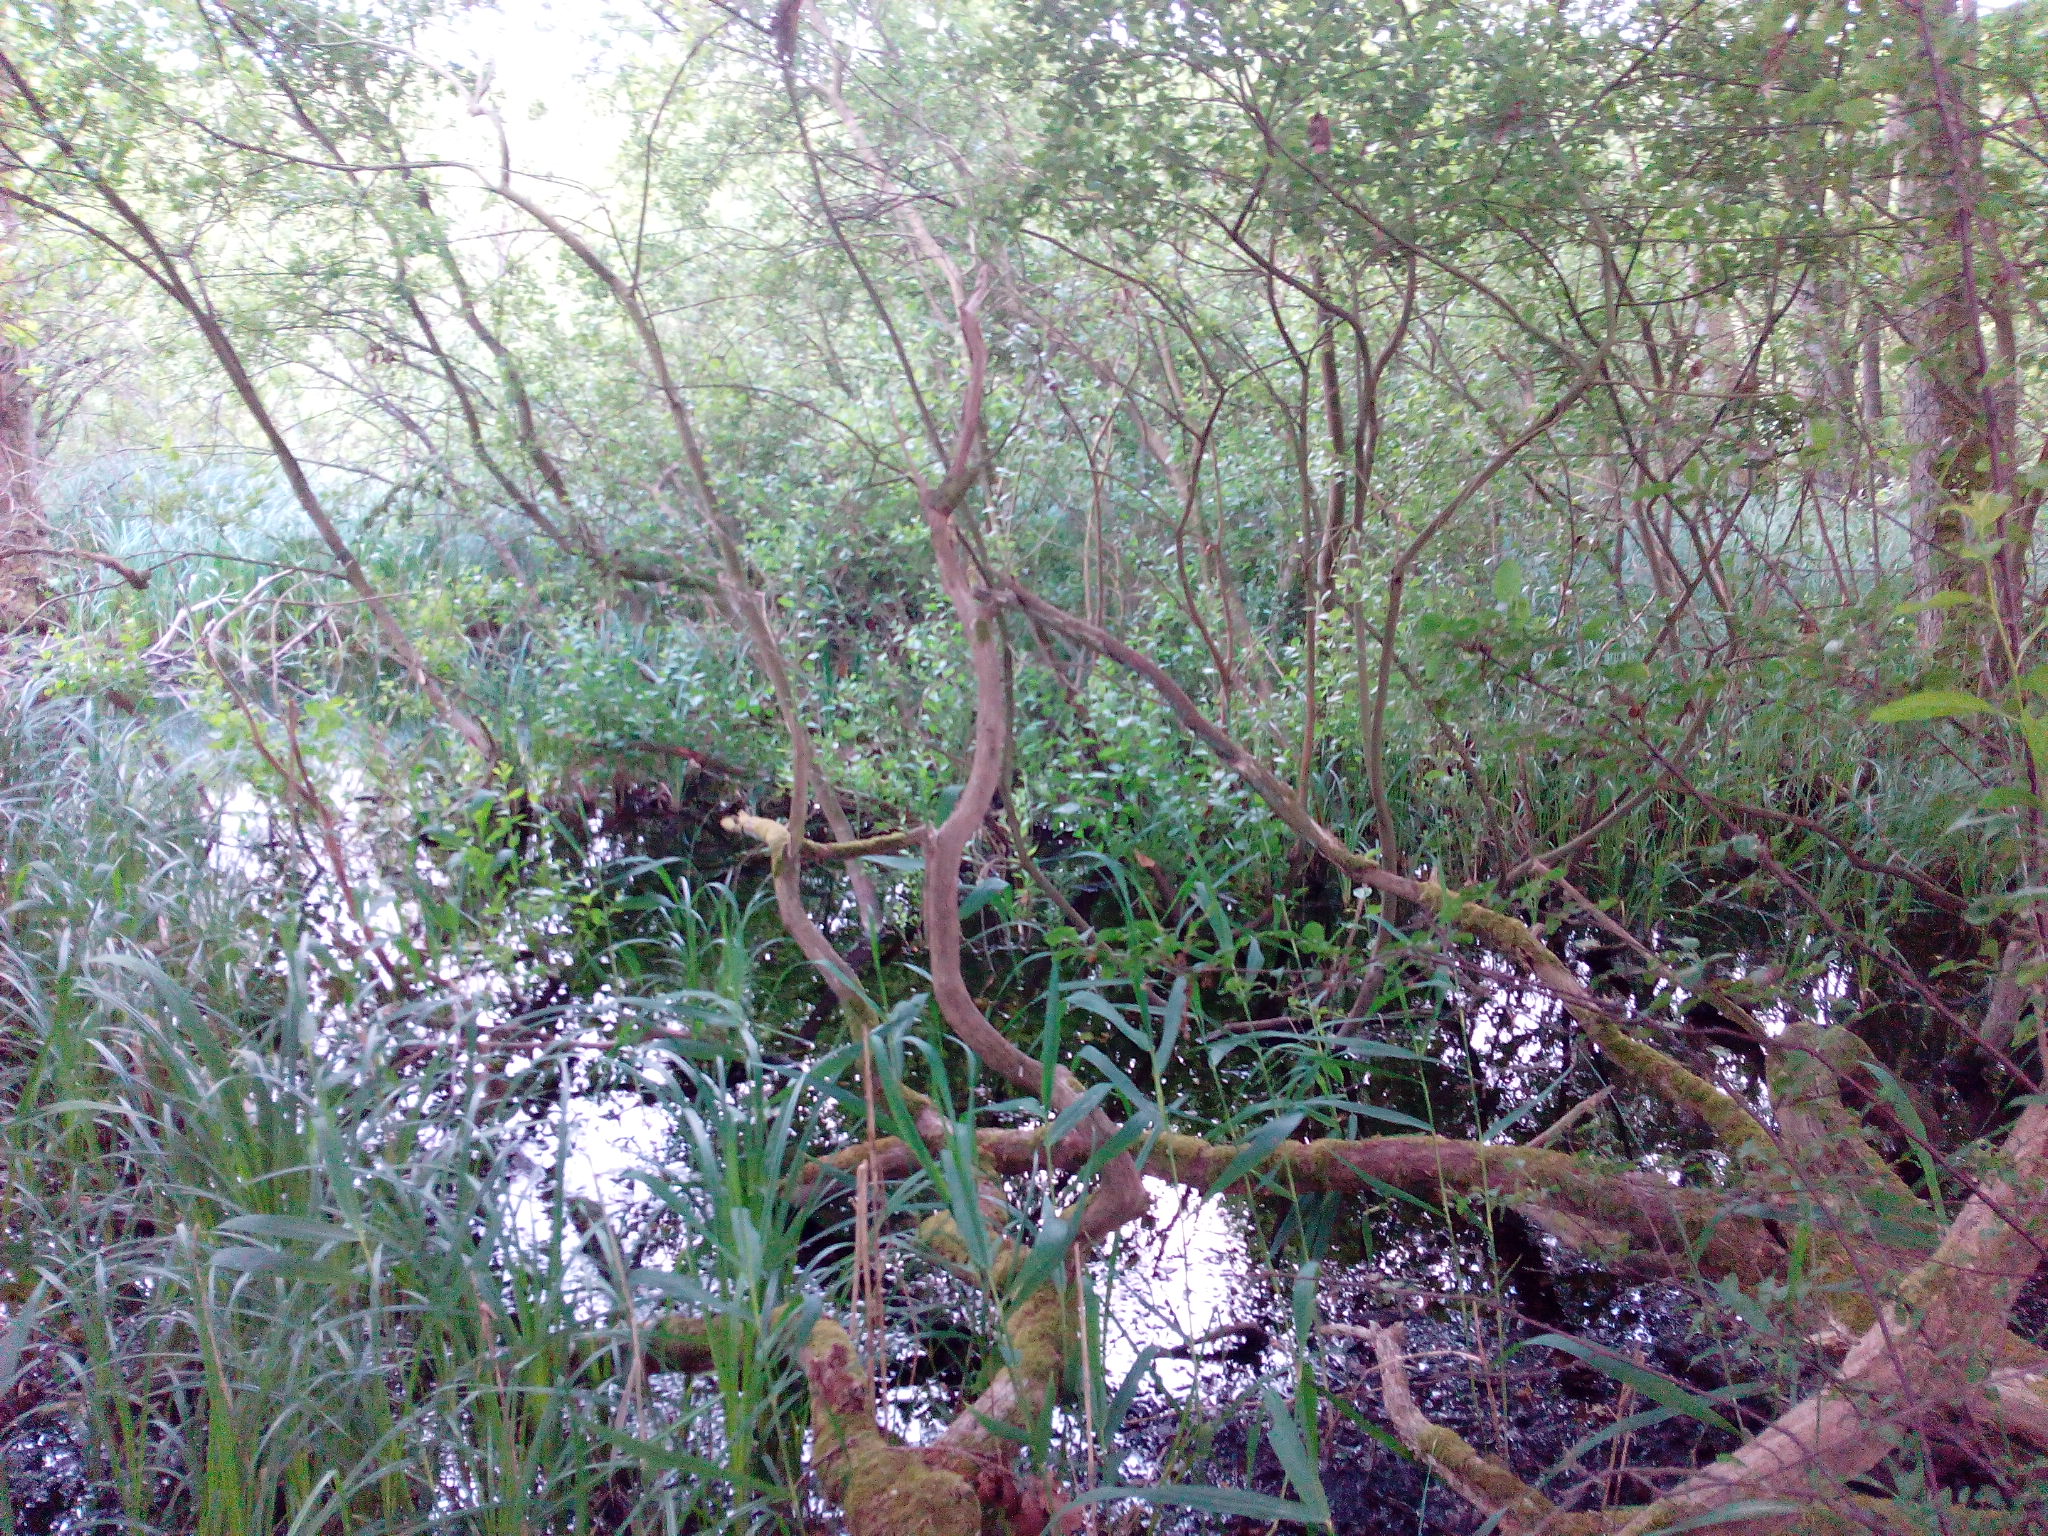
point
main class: Woodland
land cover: Broadleaved woodland
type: mesophytic deciduous forest
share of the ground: 10 - 25 %
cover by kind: herbaceous plants 40 %, broadleaved forest trees 25 %, shrubs 25 %, unconsolidated bare surface 10 %
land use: Semi-natural and natural areas not in use
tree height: > 5 m
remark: Temporary flooded
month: June
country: DE
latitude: 53.2590
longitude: 13.5827
